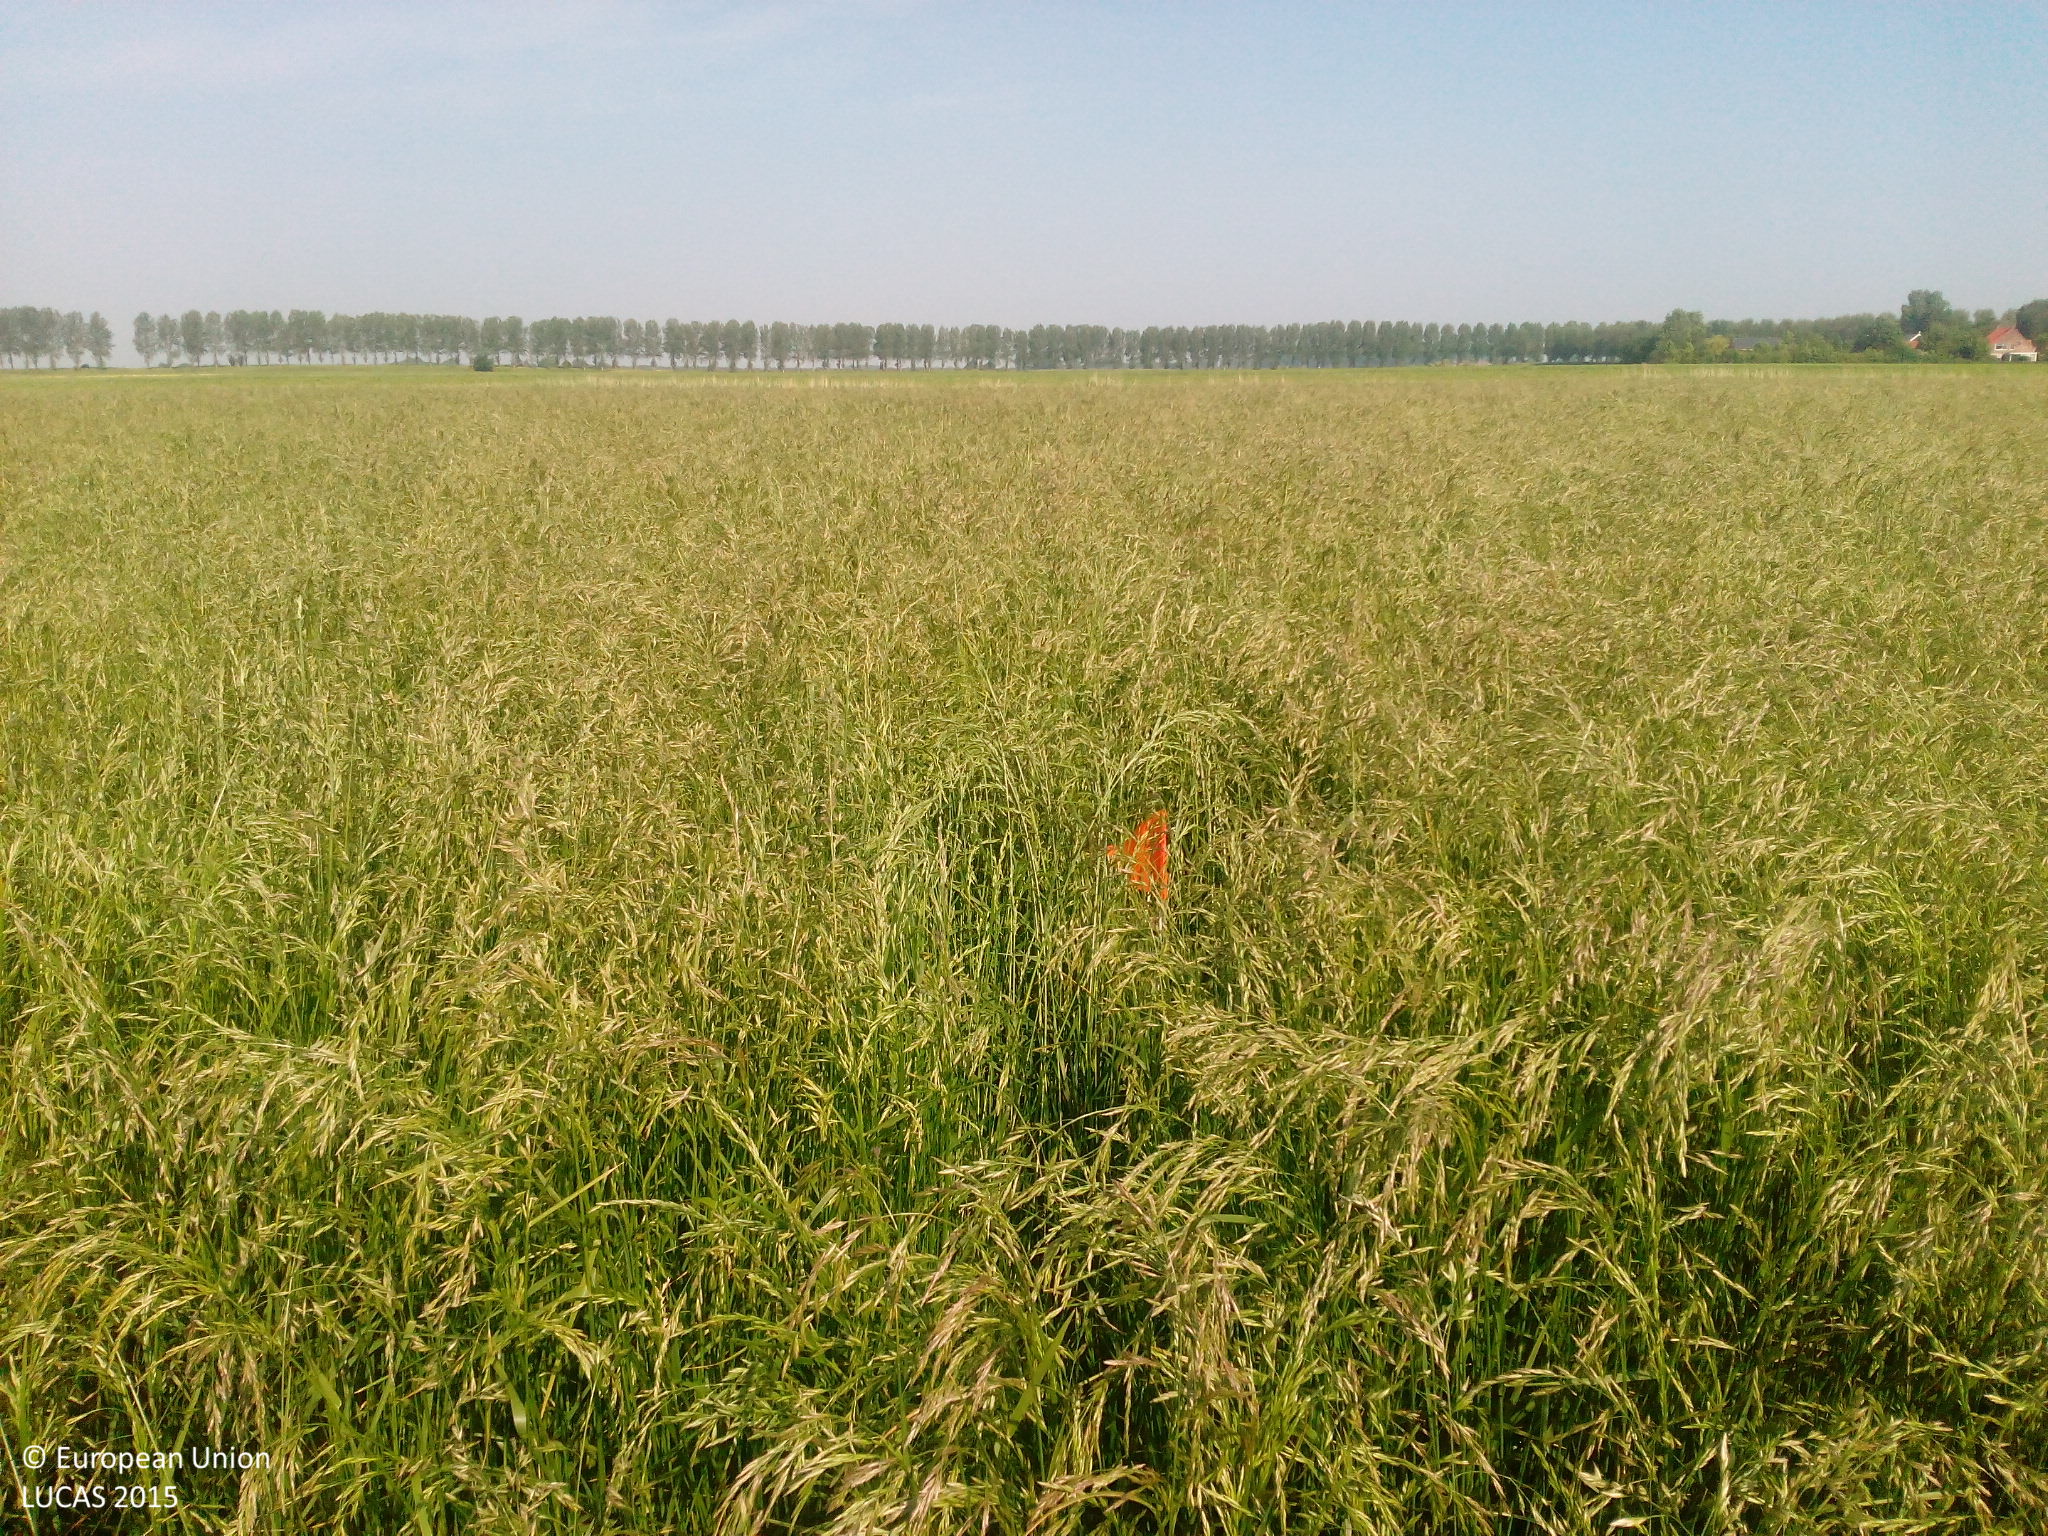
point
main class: Cropland
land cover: Temporary grasslands
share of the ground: > 75 %
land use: Agriculture (excluding fallow land and kitchen gardens)
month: June
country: NL
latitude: 51.5679
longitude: 4.1807
